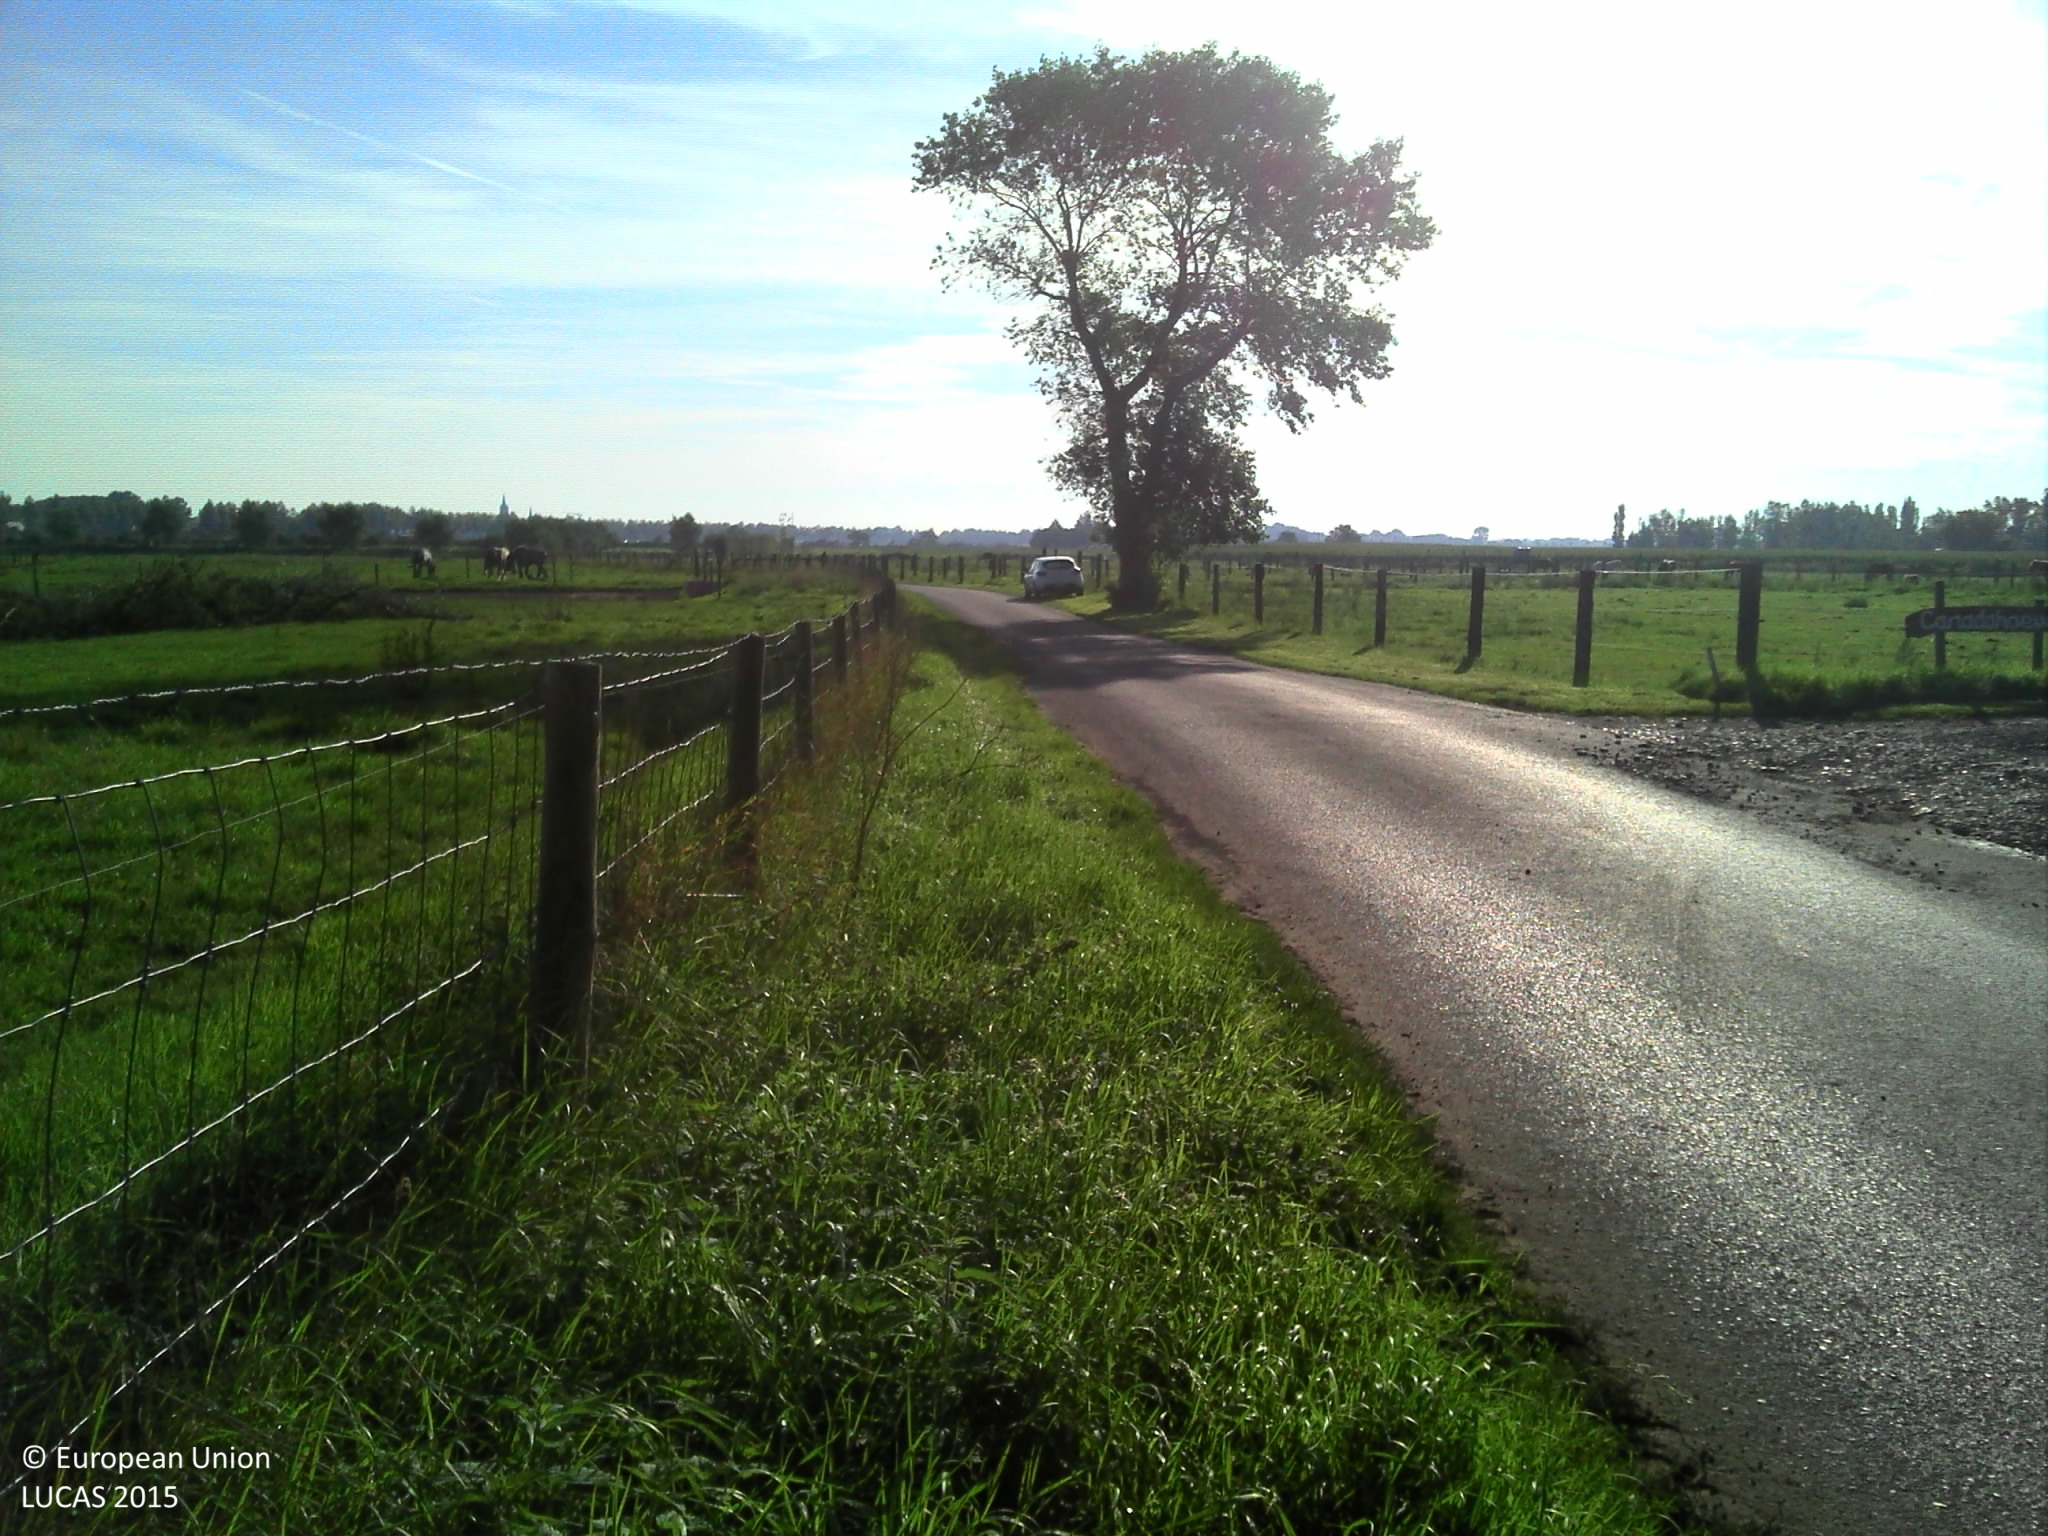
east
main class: Grassland
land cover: Grassland without tree/shrub cover
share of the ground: > 75 %
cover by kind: herbaceous plants 100 %
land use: Agriculture (excluding fallow land and kitchen gardens)
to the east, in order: Grassland without tree/shrub cover; Fences; Abandoned hedges; Fences; Grassland without tree/shrub cover; Fences; Tracks; Fences; Grassland without tree/shrub cover; Fences; Grassland without tree/shrub cover
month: September
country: BE
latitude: 51.1247
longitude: 2.7157
